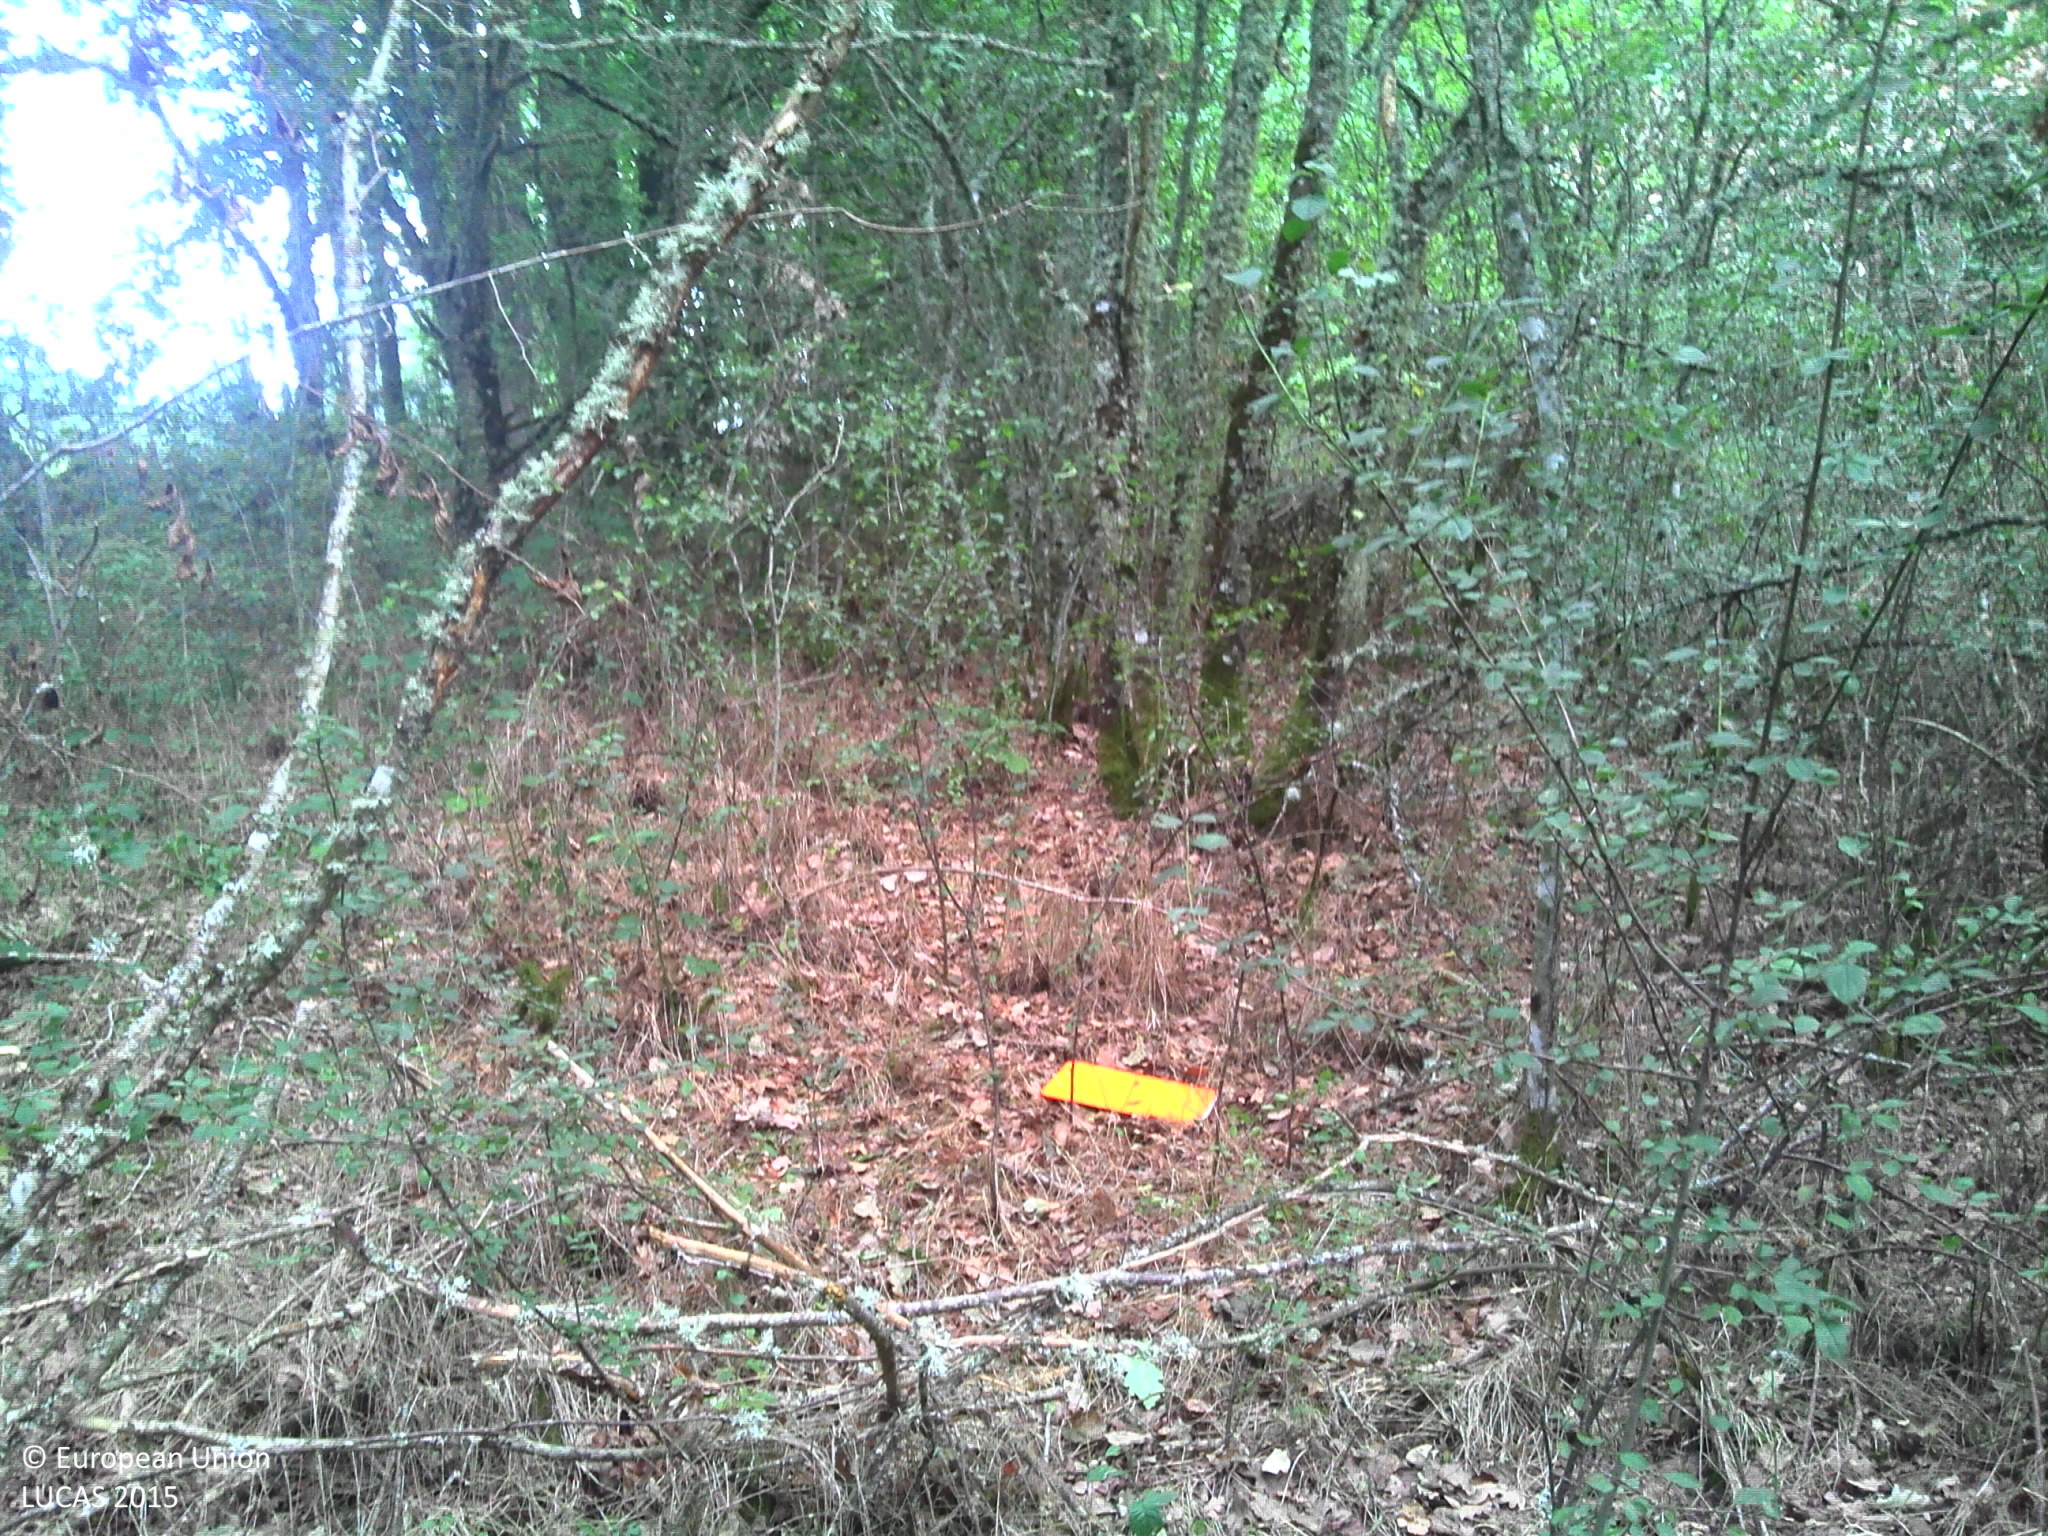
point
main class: Woodland
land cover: Broadleaved woodland
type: acidophilous oak and oak-birch forest
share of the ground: > 75 %
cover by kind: broadleaved forest trees 80 %, shrubs 10 %, herbaceous plants 10 %
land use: Forestry
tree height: > 5 m
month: August
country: FR
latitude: 46.0001
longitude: 2.2870
